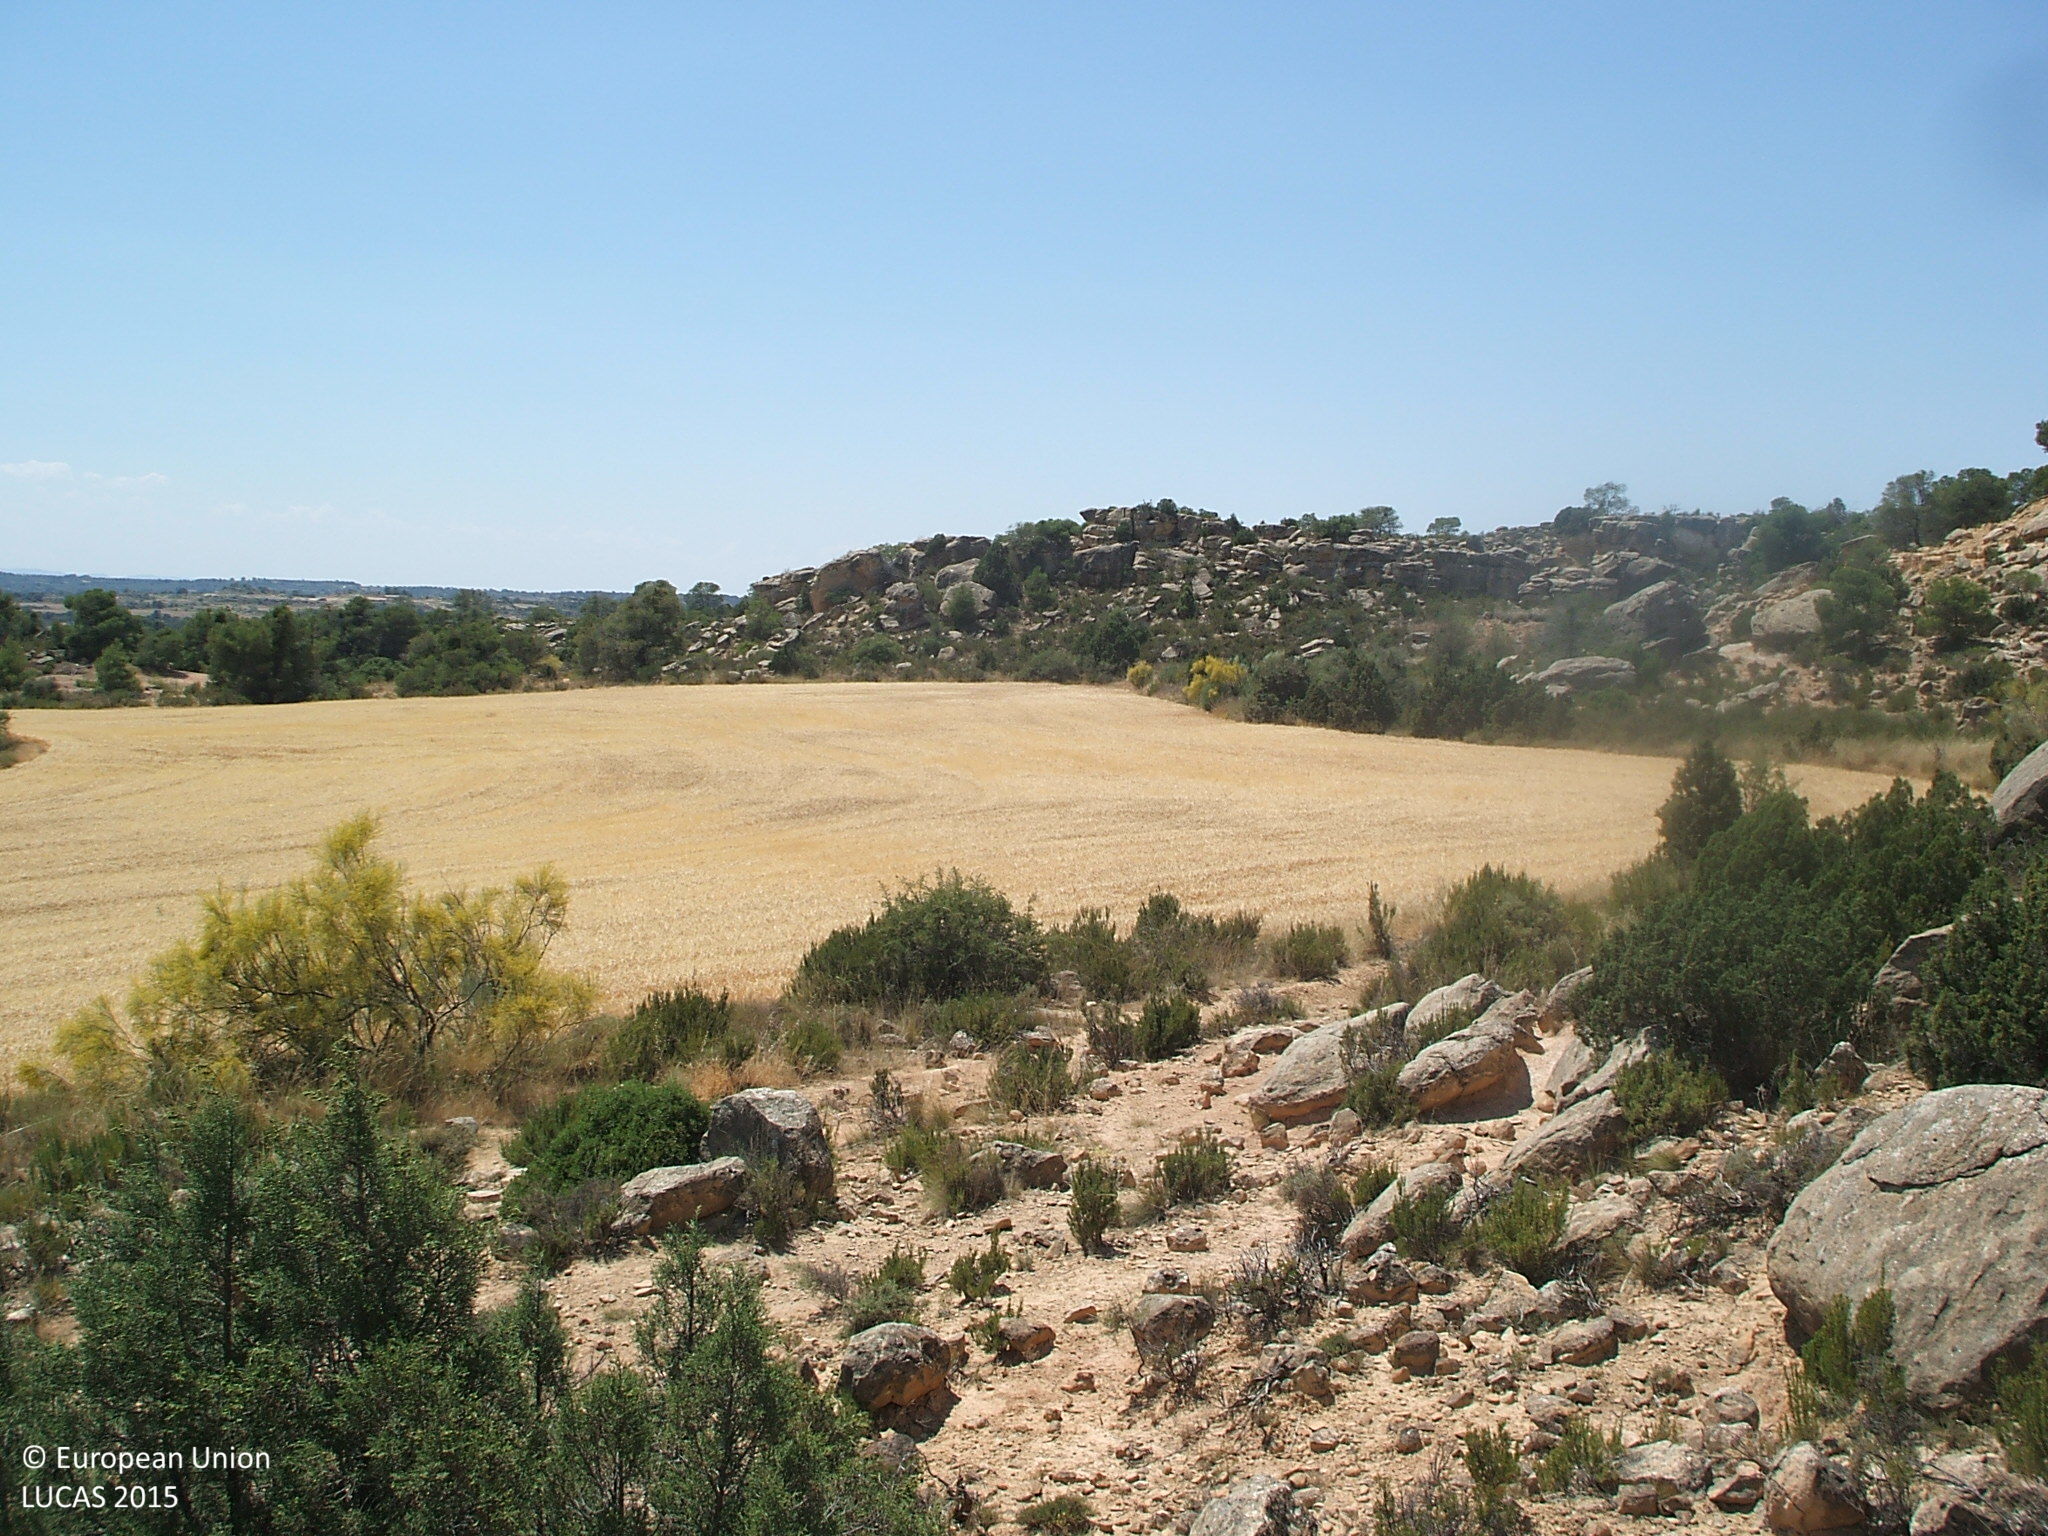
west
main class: Woodland
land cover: Pine dominated coniferous woodland
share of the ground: 10 - 25 %
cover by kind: consolidated bare surface 65 %, shrubs 20 %, coniferous forest trees 15 %
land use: Semi-natural and natural areas not in use
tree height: < 5 m
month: June
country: ES
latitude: 41.1289
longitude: -0.1011
